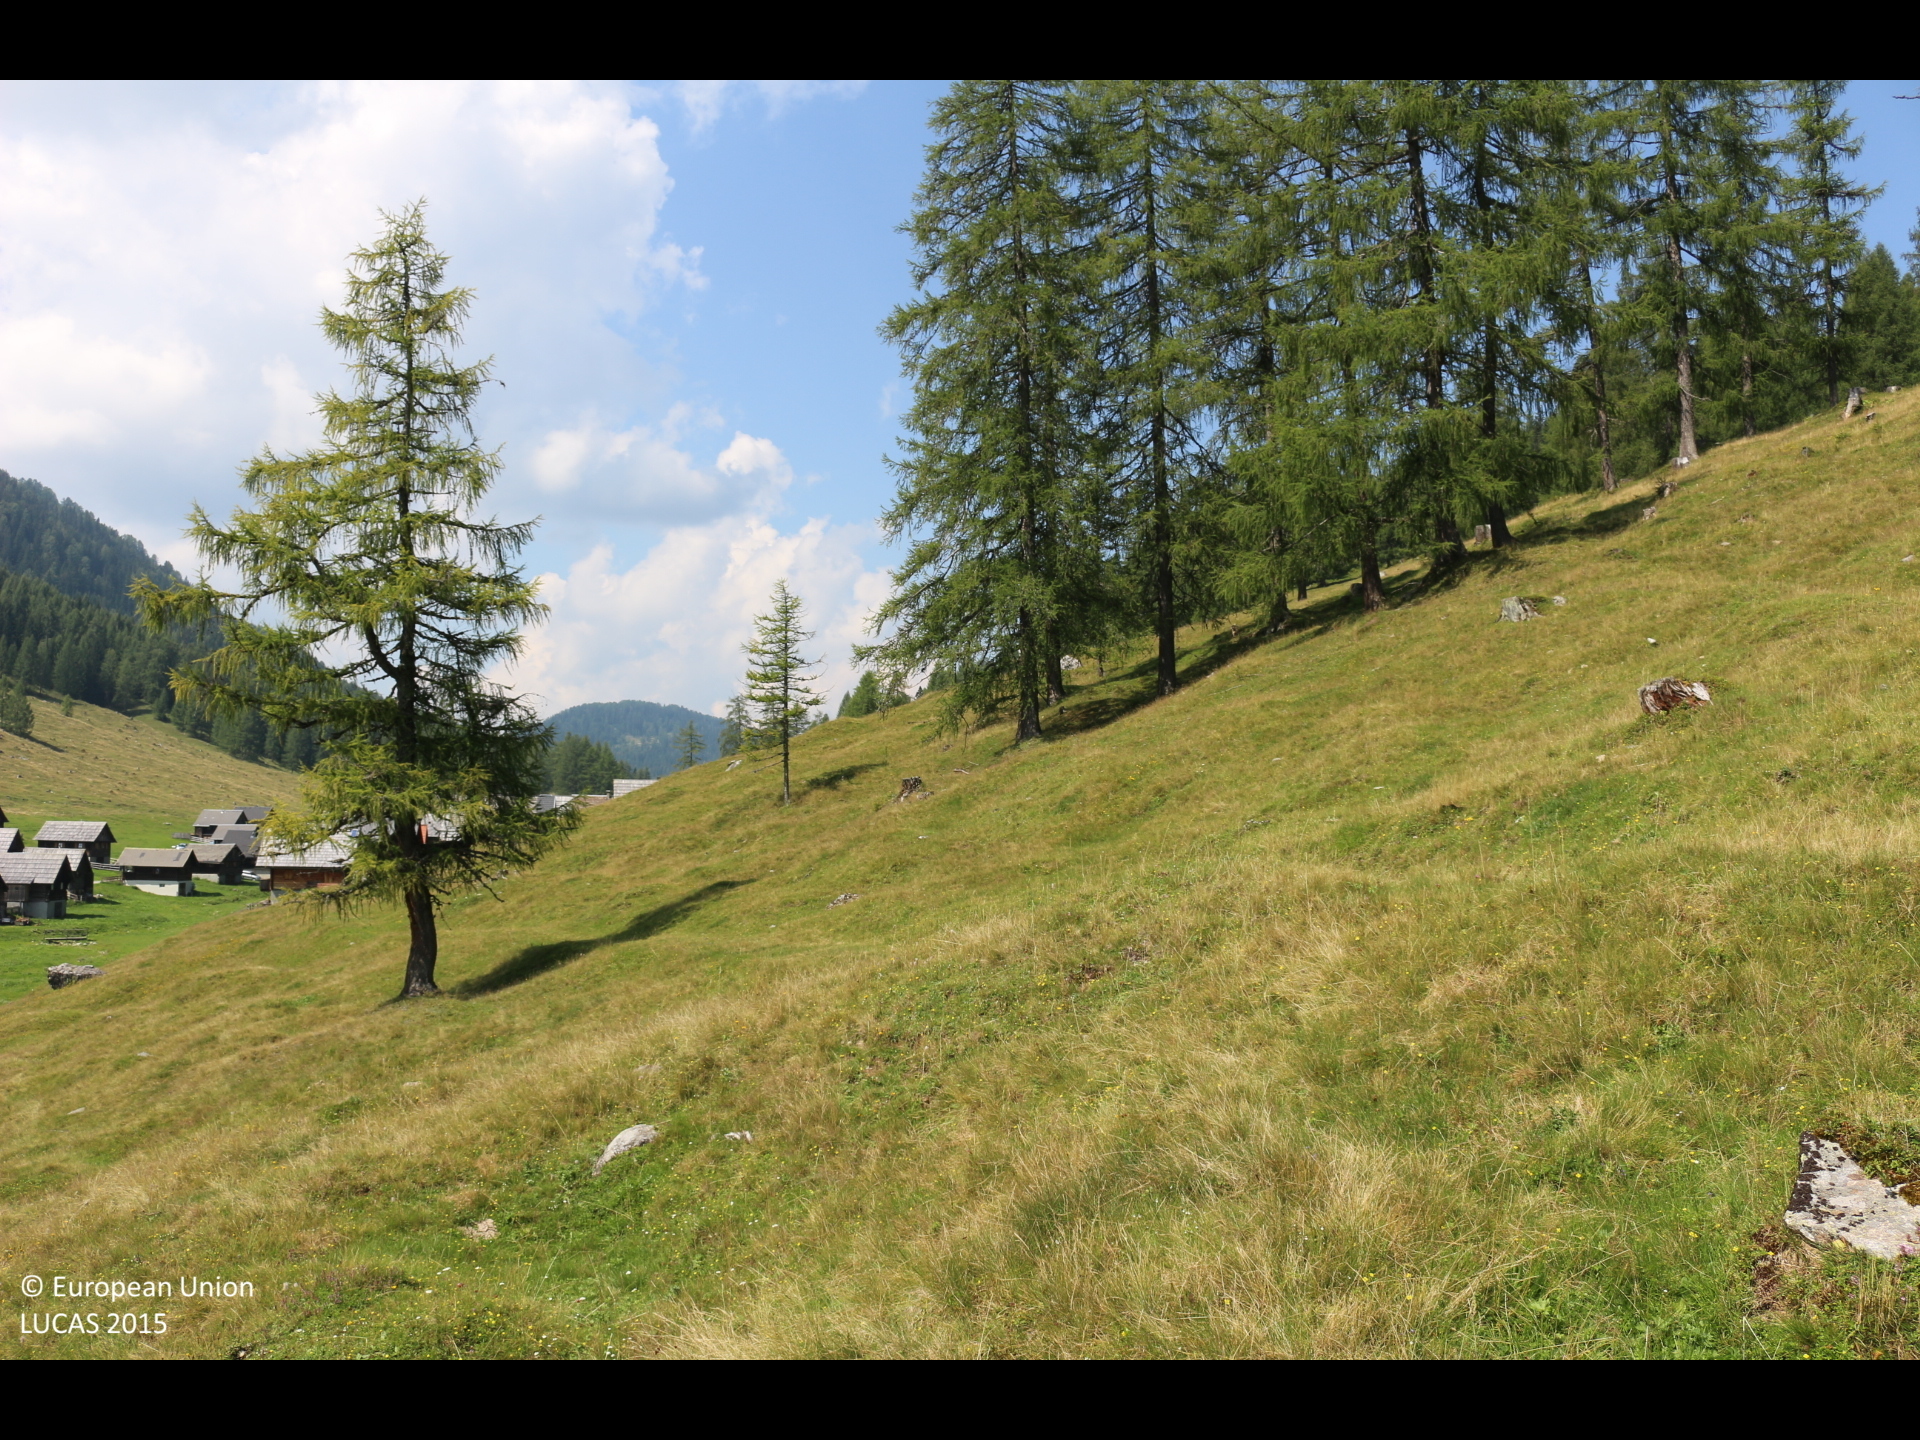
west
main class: Grassland
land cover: Grassland without tree/shrub cover
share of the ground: > 75 %
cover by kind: herbaceous plants 100 %
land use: Agriculture (excluding fallow land and kitchen gardens)
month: August
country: AT
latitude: 46.5847
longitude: 13.4294
